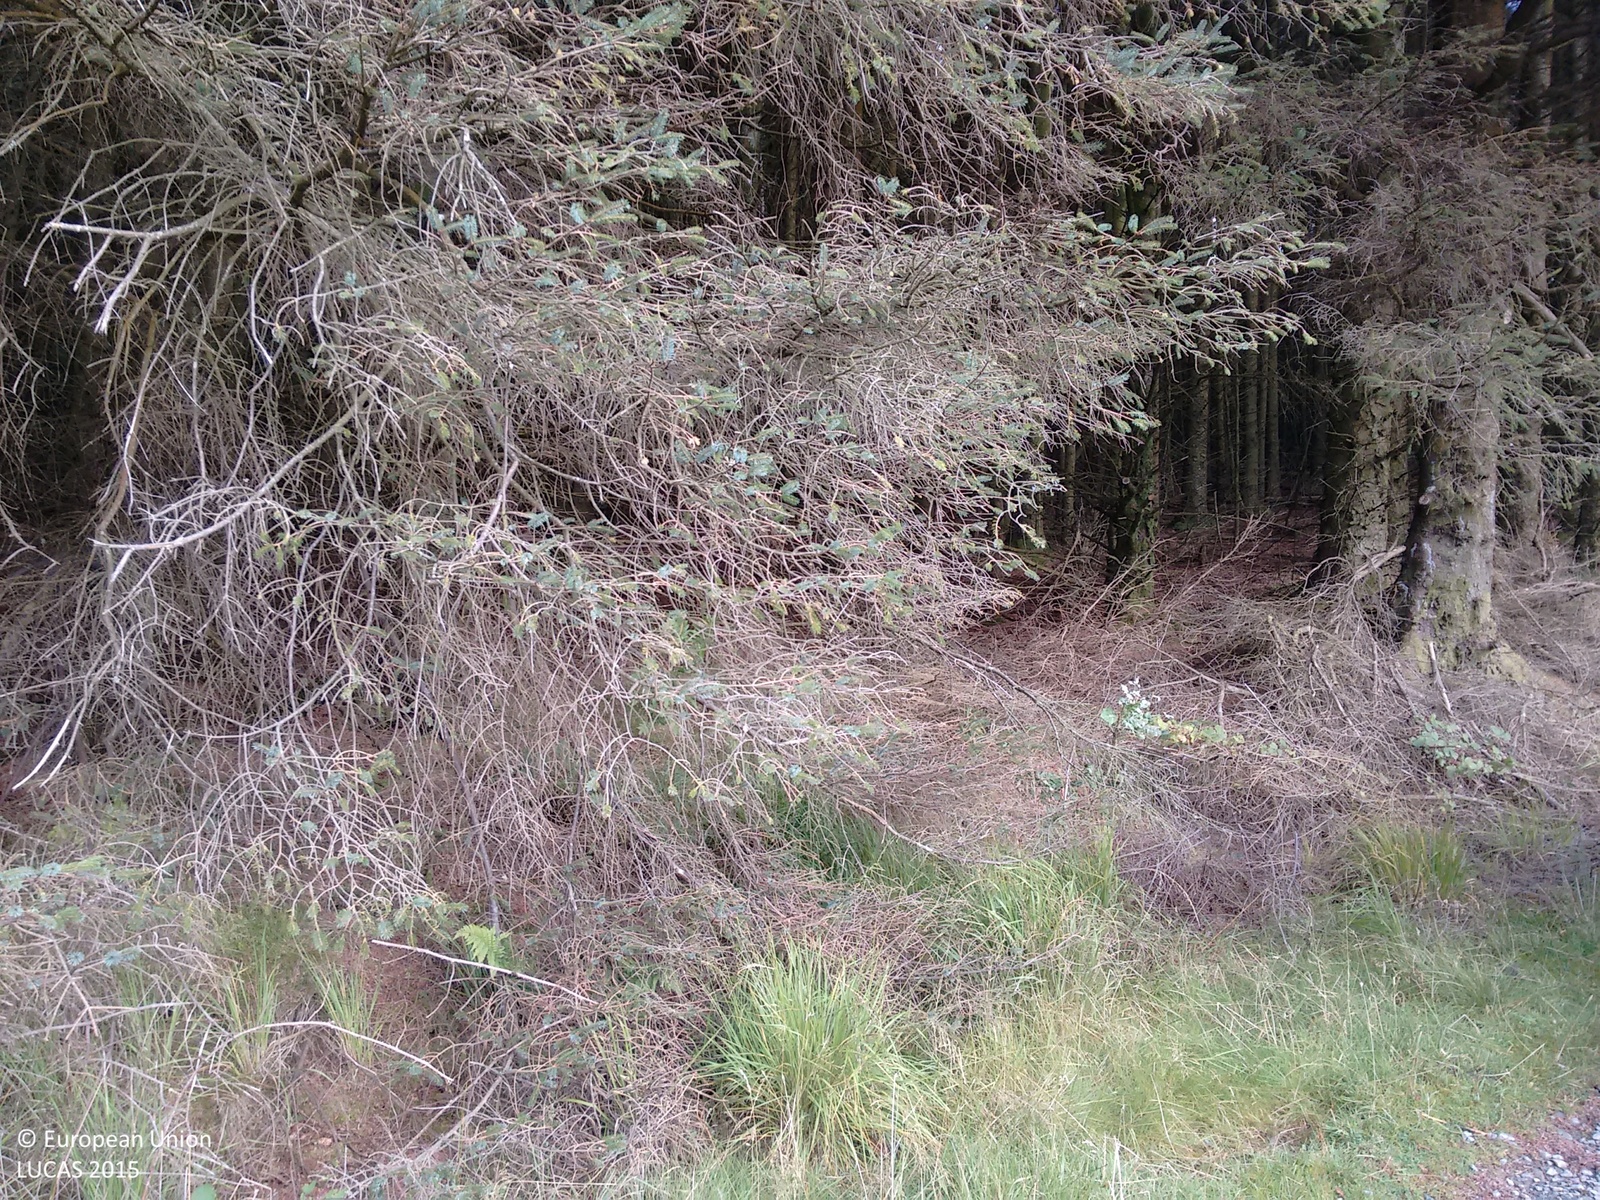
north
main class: Shrubland
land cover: Shrubland without tree cover
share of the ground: > 75 %
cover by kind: shrubs 100 %
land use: Semi-natural and natural areas not in use
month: October
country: GB
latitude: 52.4689
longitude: -3.8851
